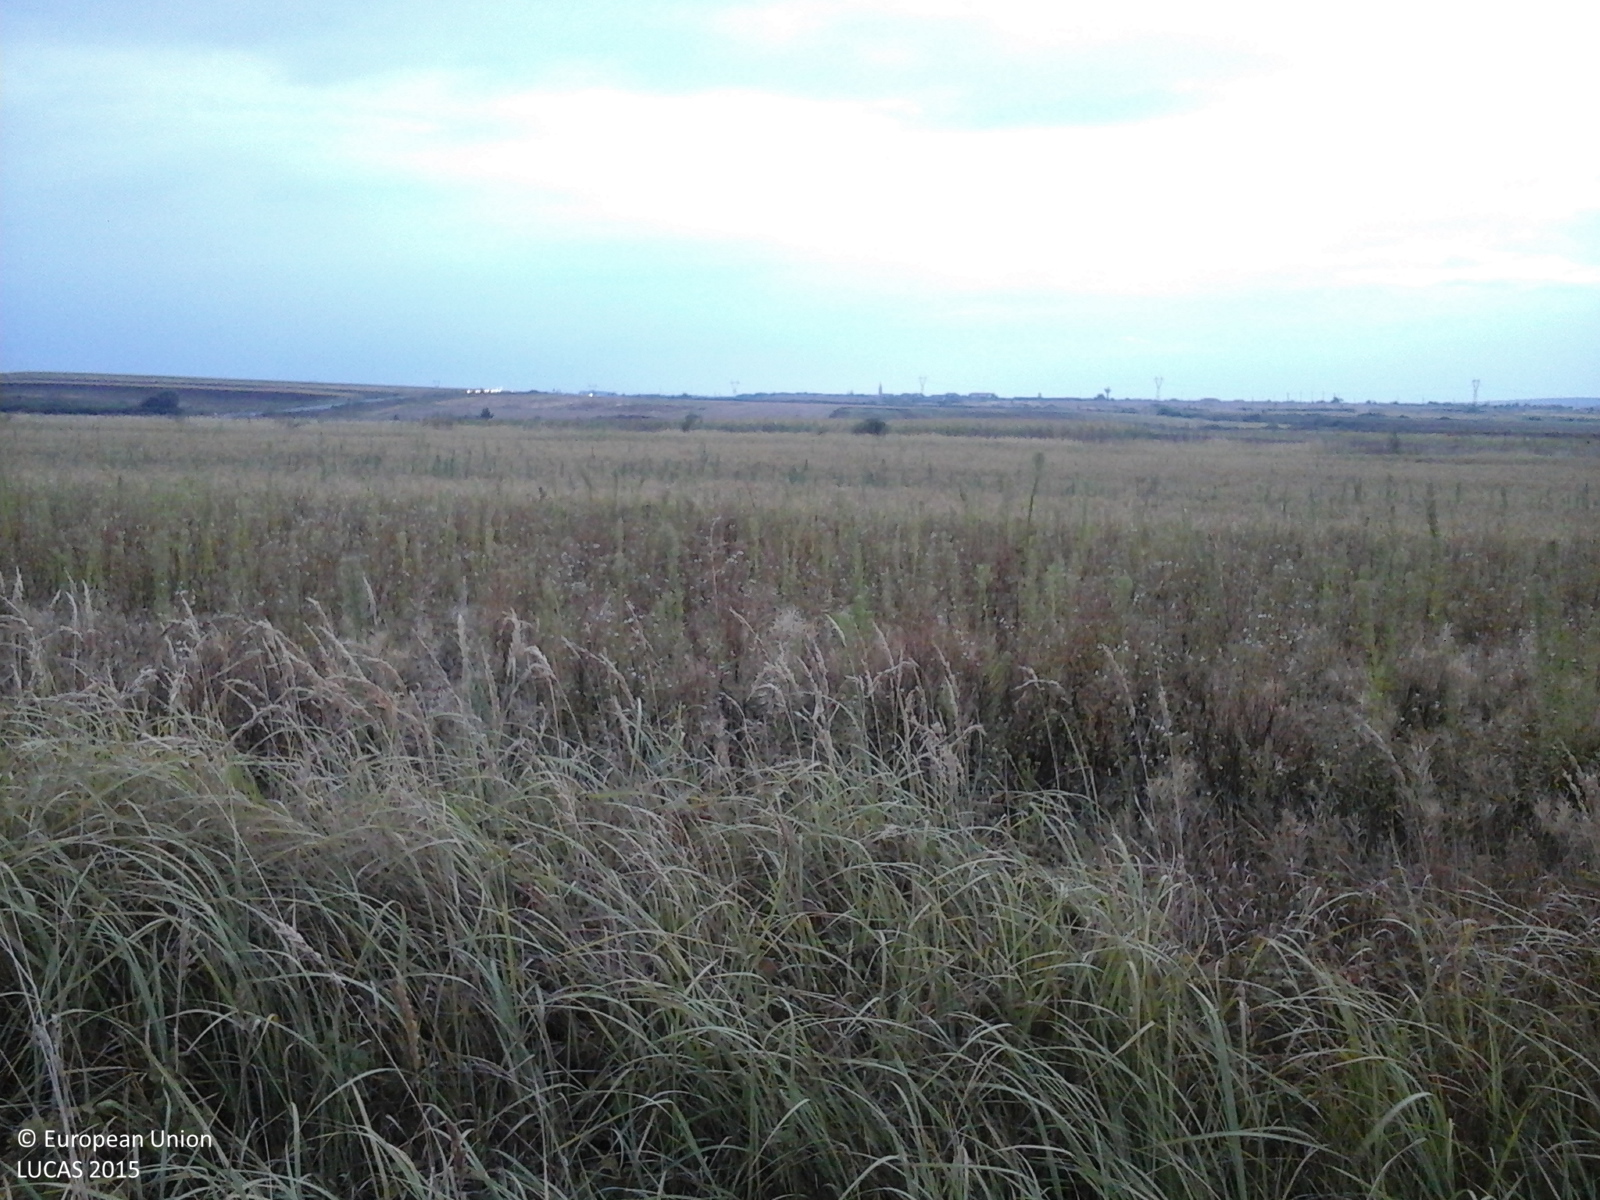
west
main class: Grassland
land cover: Spontaneously vegetated surfaces
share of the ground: > 75 %
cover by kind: herbaceous plants 100 %
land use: Fallow land
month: August
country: RO
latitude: 45.7961
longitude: 21.5490
